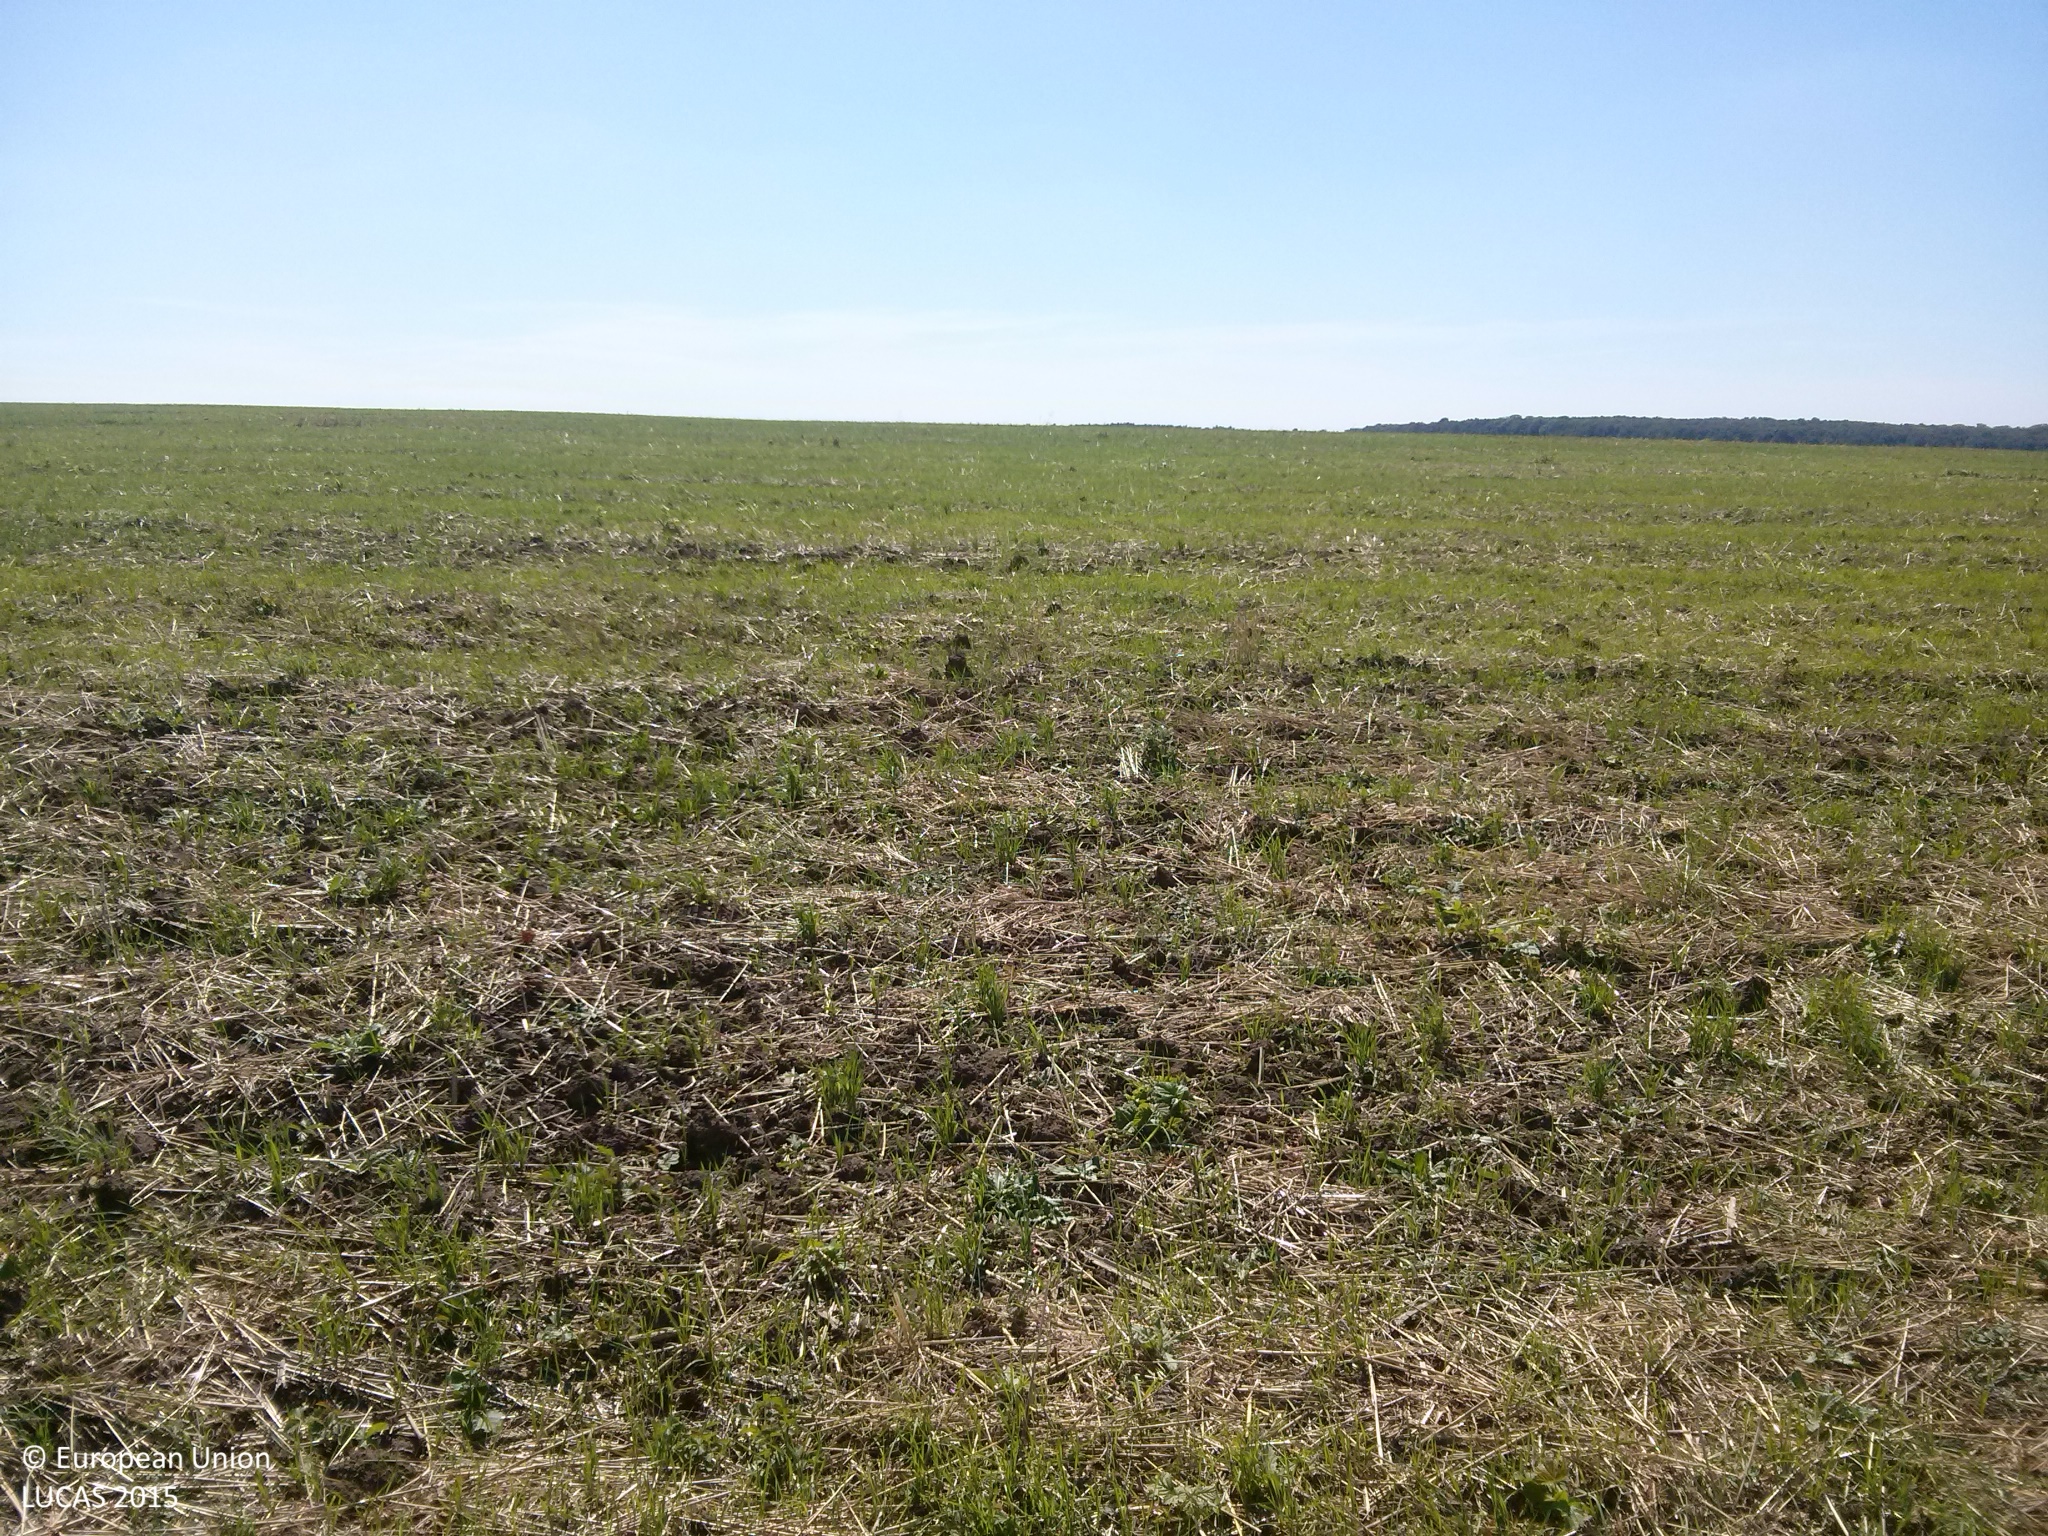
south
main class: Cropland
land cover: Common wheat
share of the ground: < 10 %
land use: Agriculture (excluding fallow land and kitchen gardens)
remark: Harvested field
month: September
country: BG
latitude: 43.6757
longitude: 26.4152
